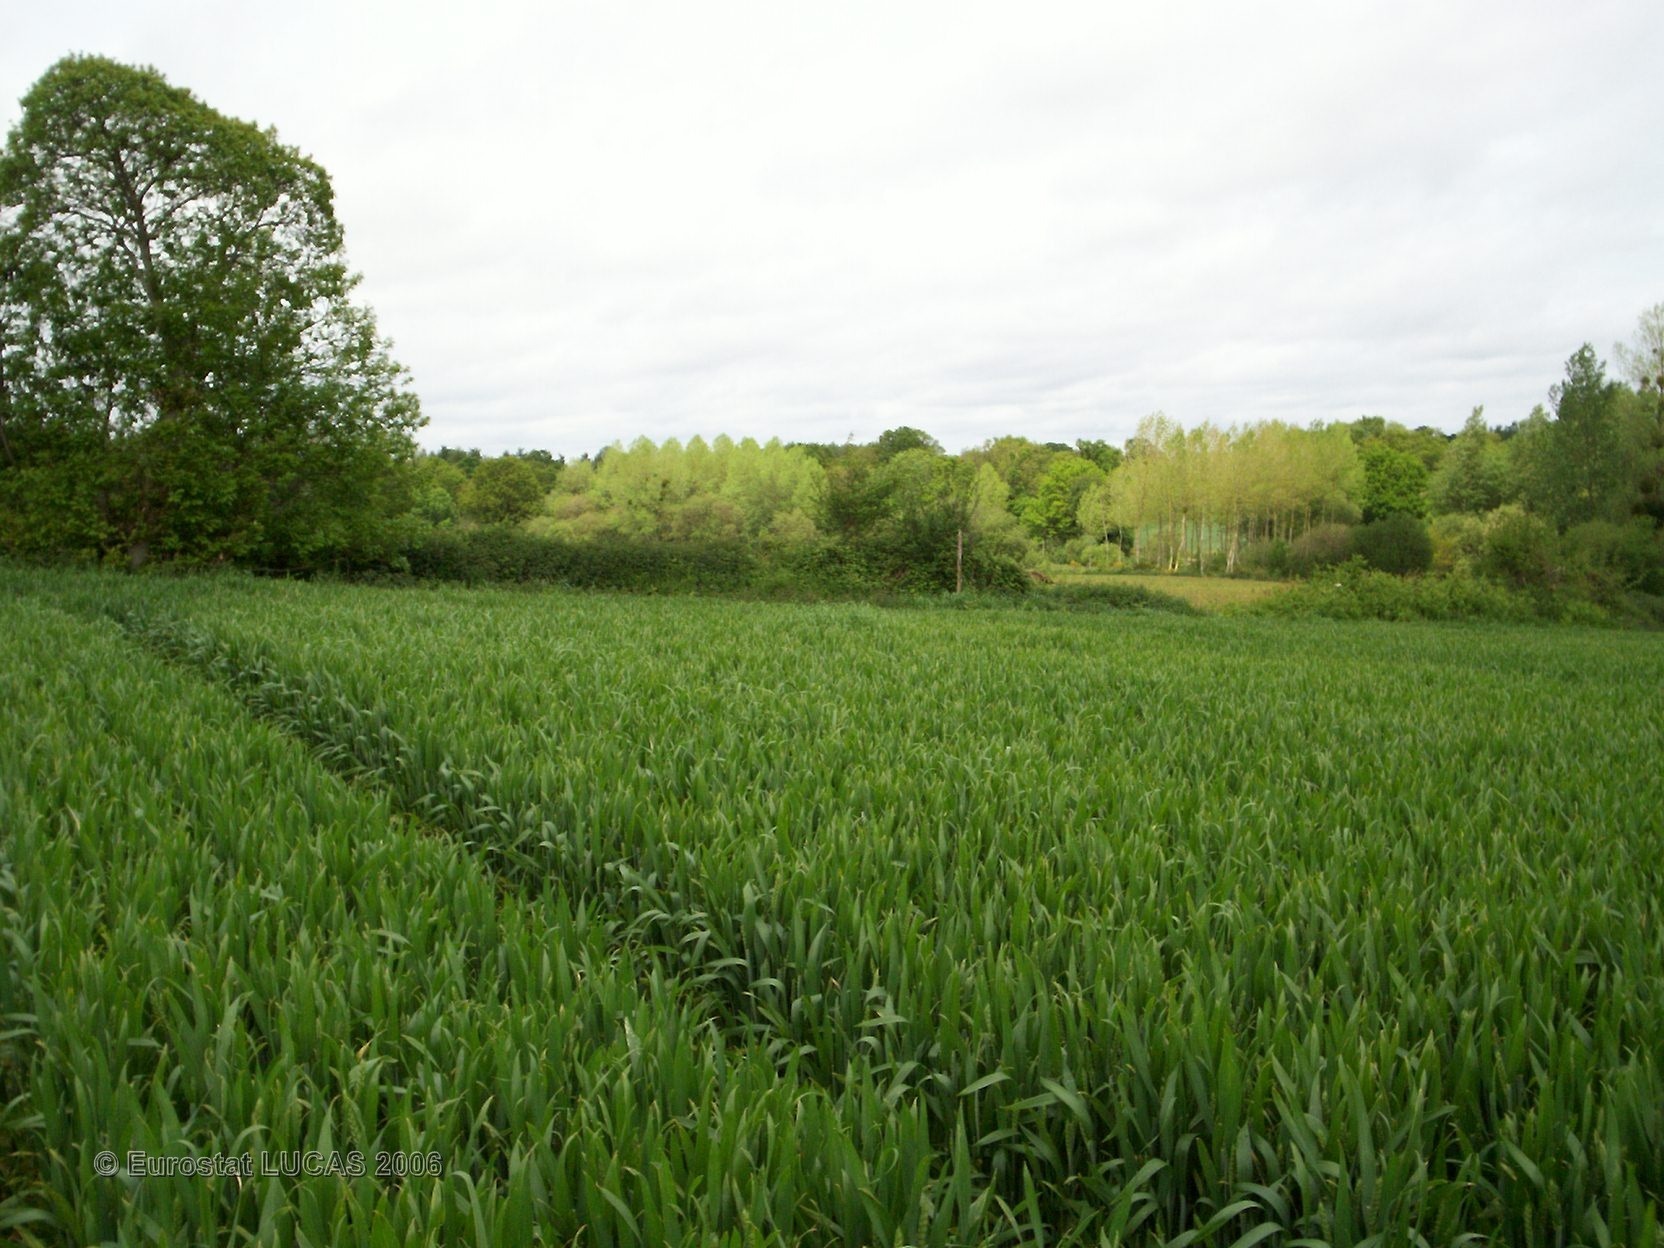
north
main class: Cropland
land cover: Common wheat
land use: Agriculture (excluding fallow land and kitchen gardens)
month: May
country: FR
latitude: 48.6309
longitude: -3.0291
